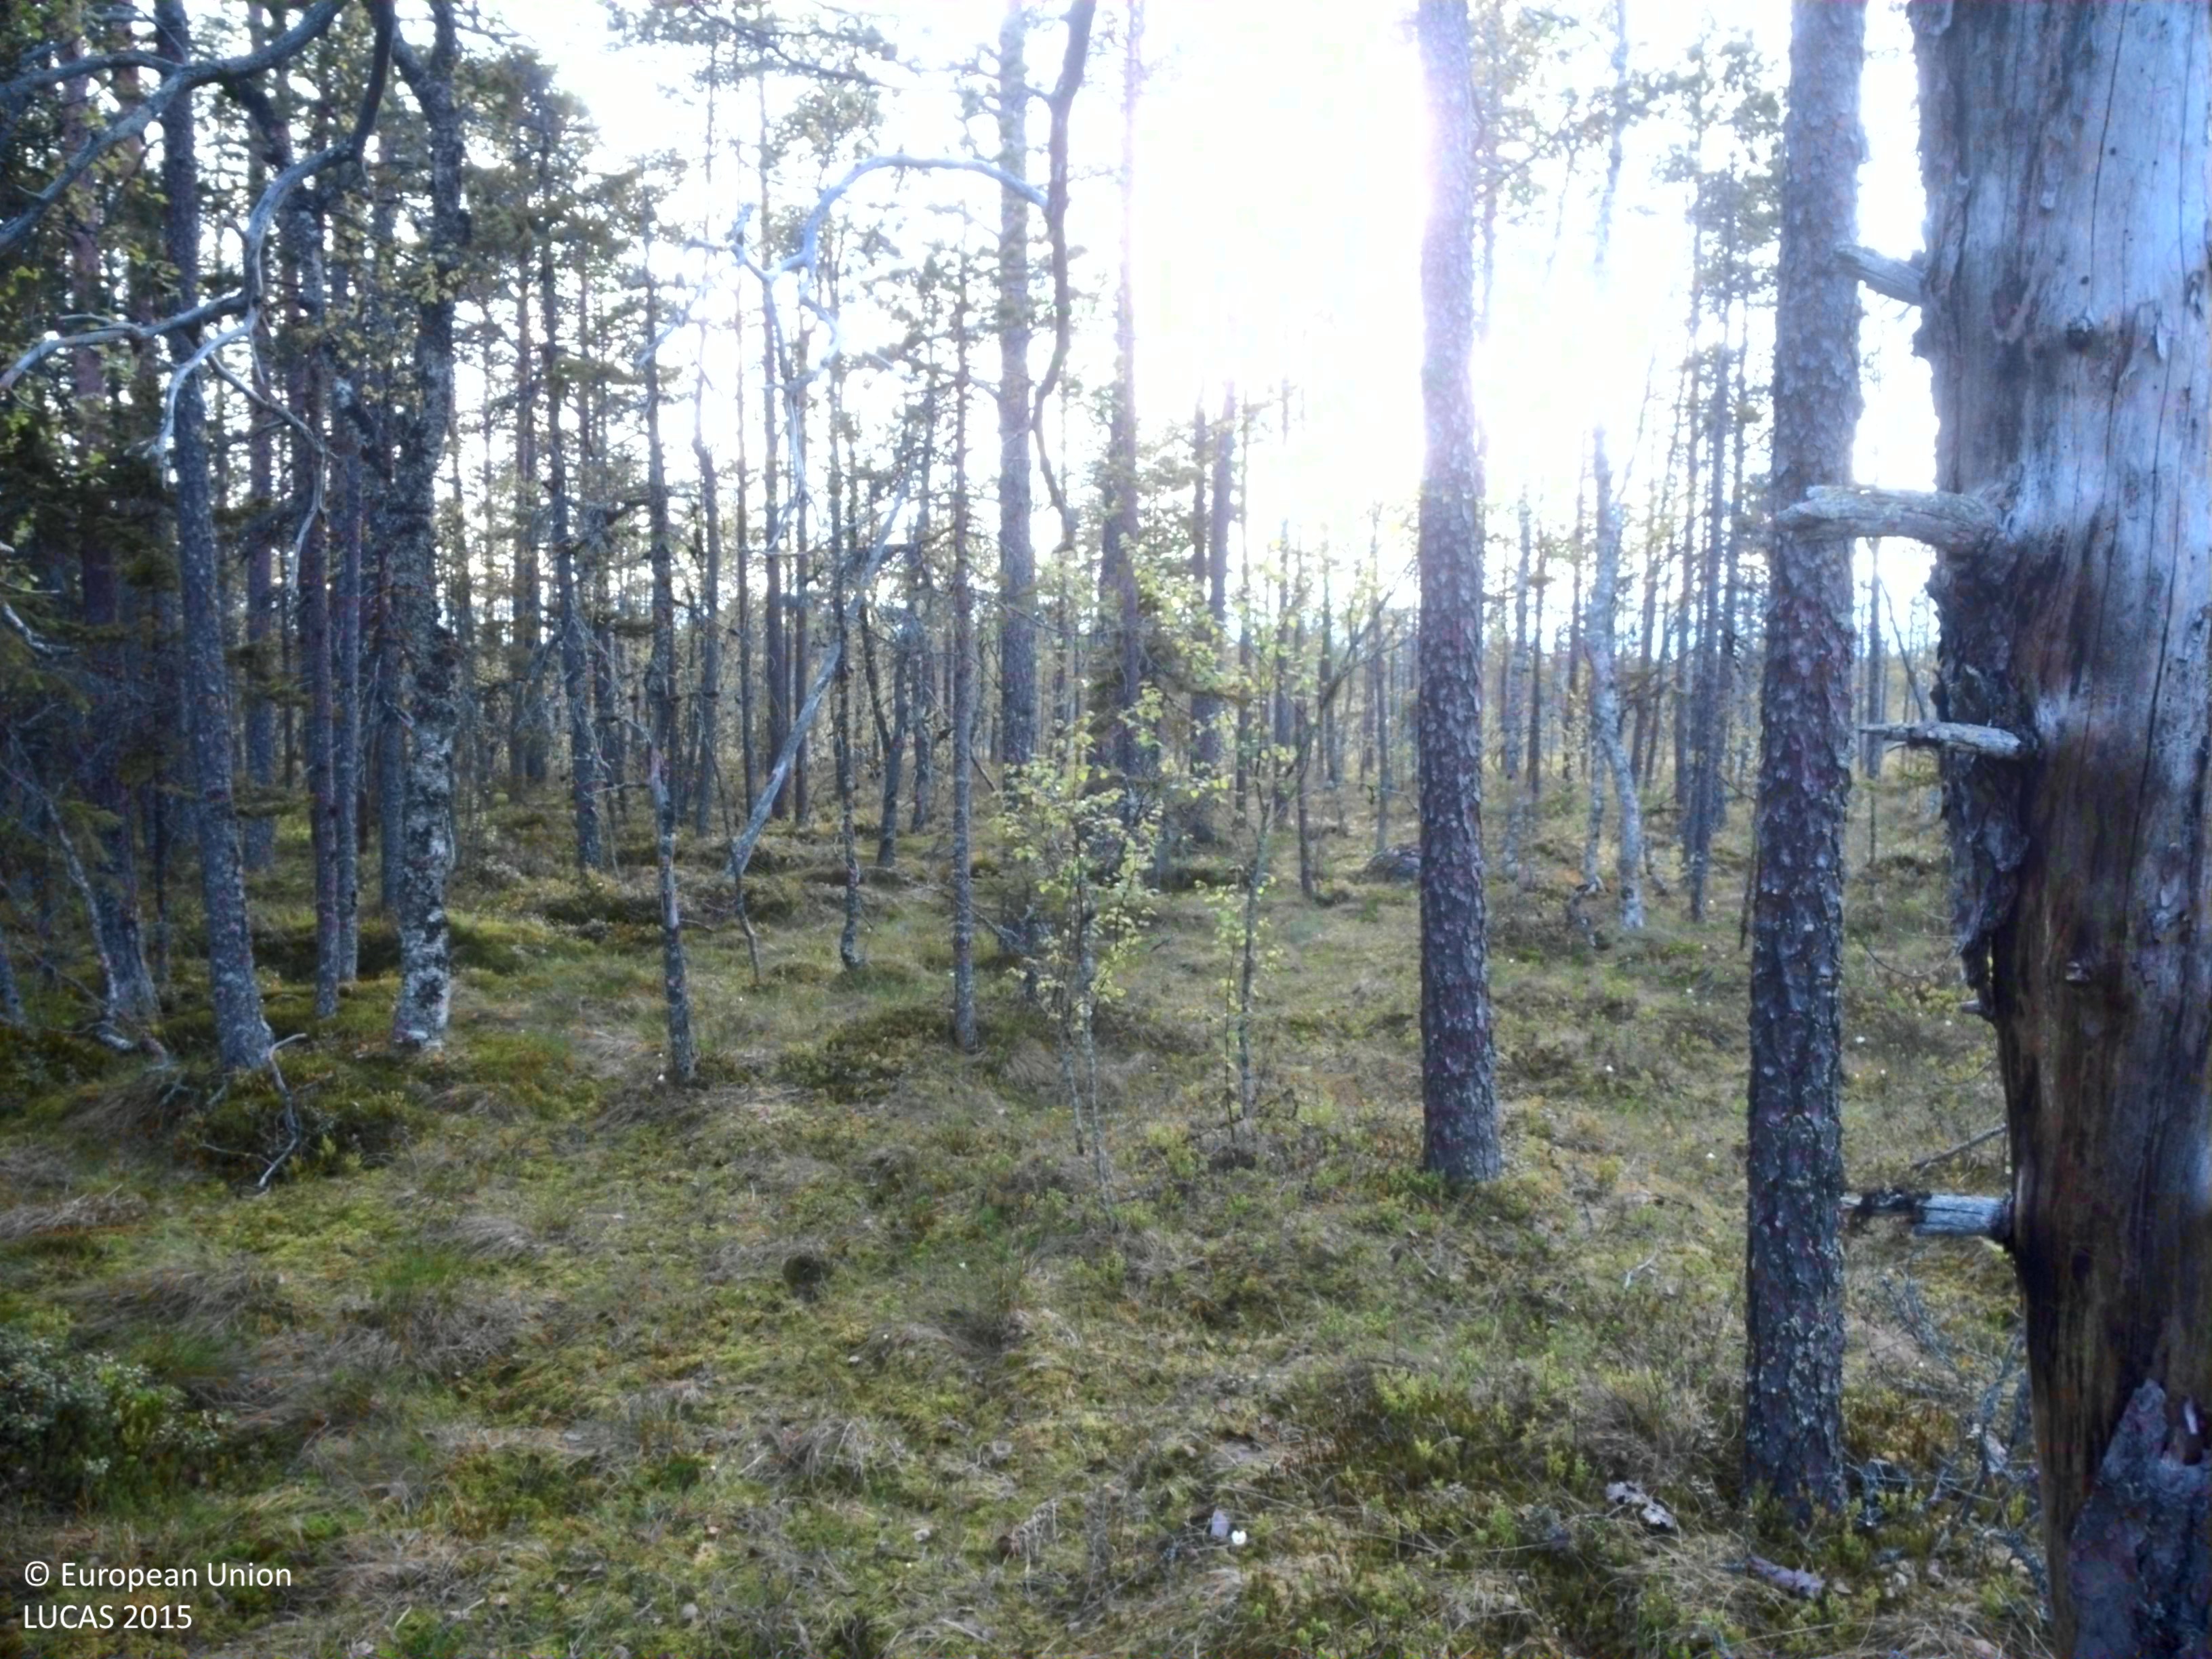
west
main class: Woodland
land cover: Pine dominated mixed woodland
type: boreal forest
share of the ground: 25 - 50 %
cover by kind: coniferous forest trees 30 %, shrubs 20 %, herbaceous plants 20 %, lichens and mosses 20 %, broadleaved forest trees 10 %
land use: Forestry
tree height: > 5 m
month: June
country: SE
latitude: 63.8557
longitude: 20.6635
